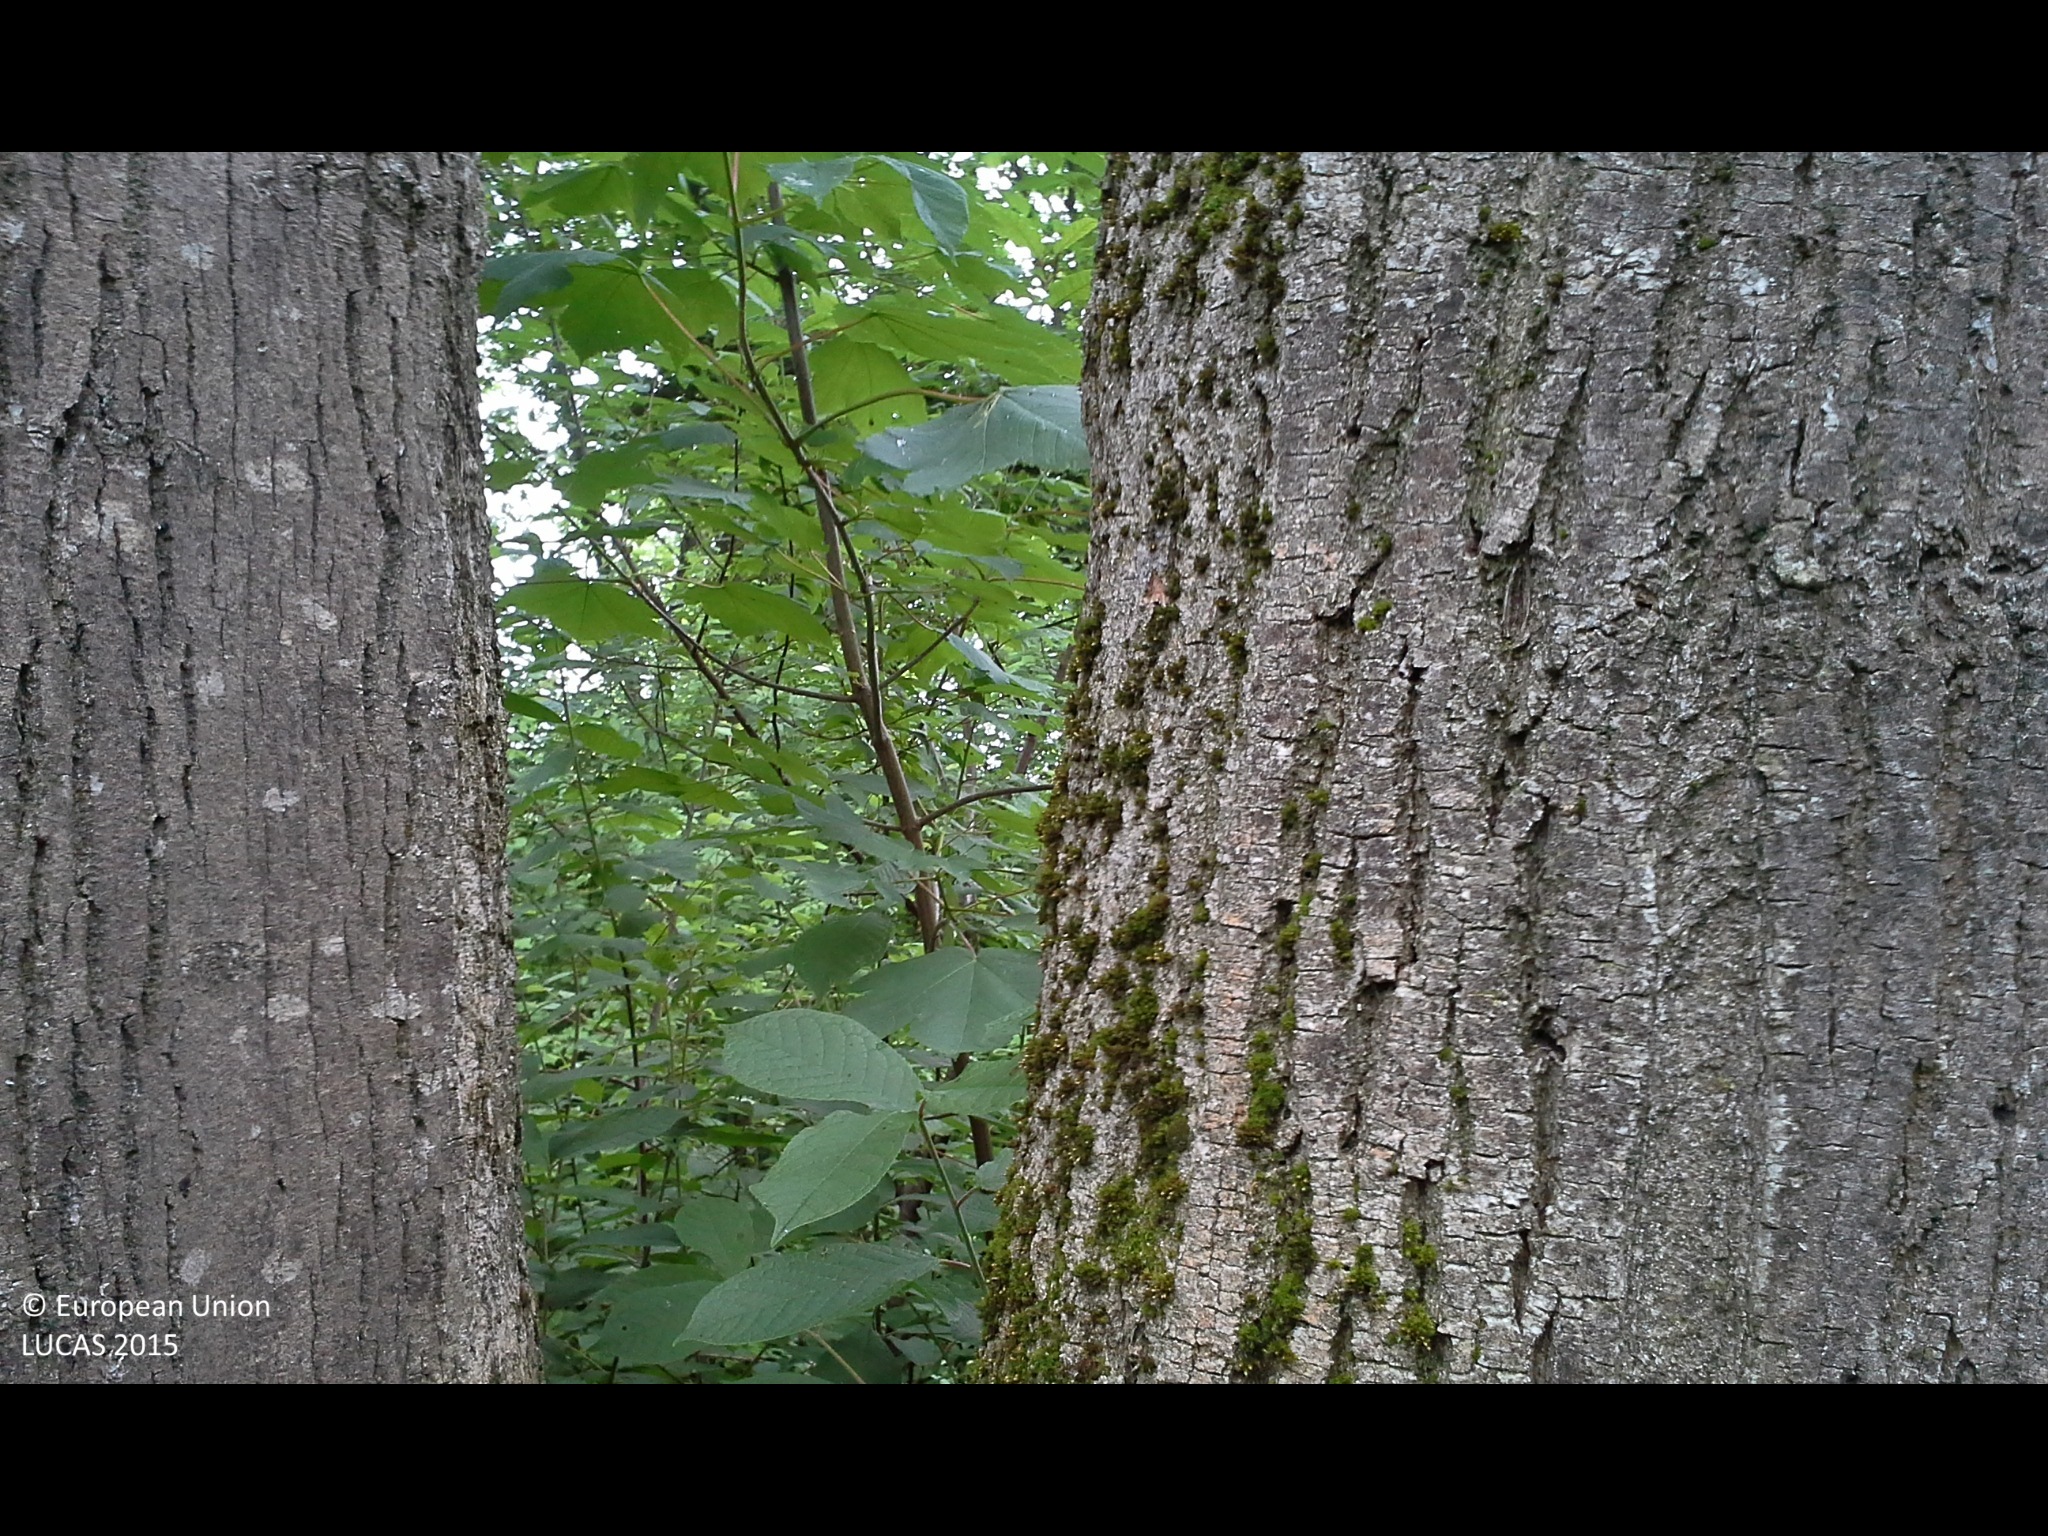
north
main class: Woodland
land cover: Broadleaved woodland
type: floodplain forest
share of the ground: > 75 %
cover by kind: broadleaved forest trees 80 %, shrubs 20 %
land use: Forestry
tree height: > 5 m
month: May
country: AT
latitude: 48.1602
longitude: 14.2348
